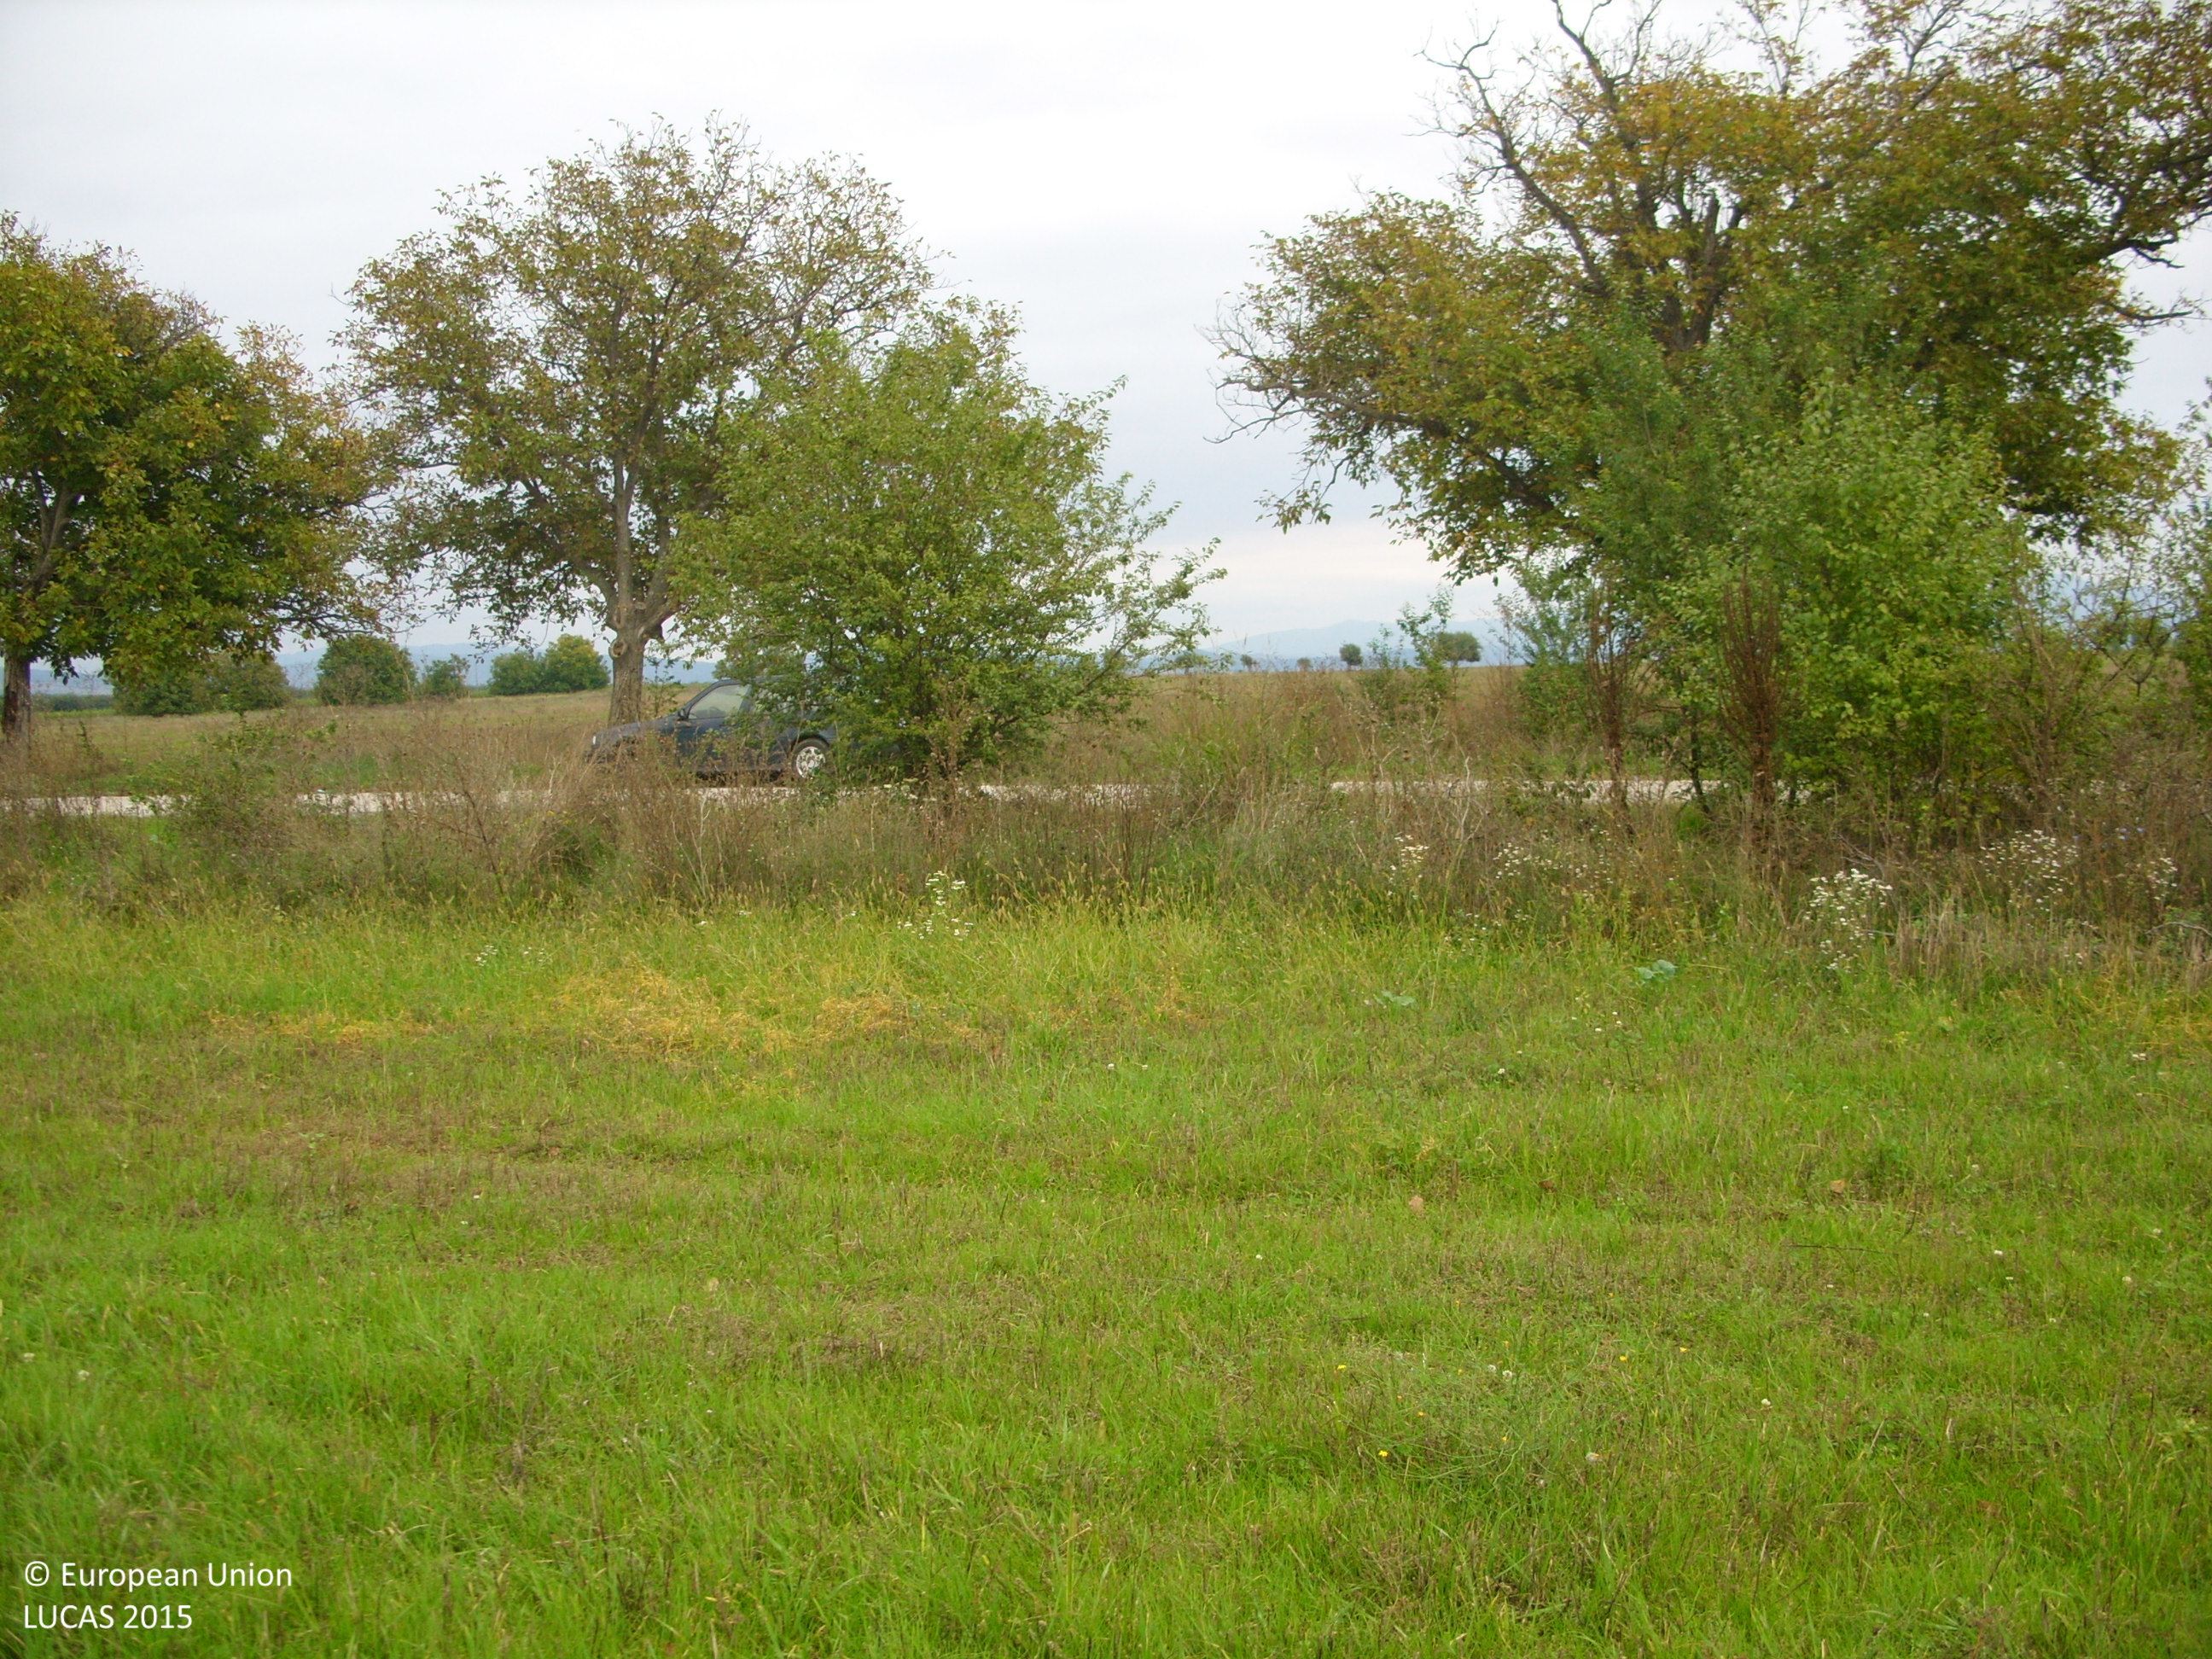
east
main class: Grassland
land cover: Grassland without tree/shrub cover
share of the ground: > 75 %
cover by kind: herbaceous plants 100 %
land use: Agriculture (excluding fallow land and kitchen gardens)
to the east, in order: Grassland without tree/shrub cover; Lines of trees; Paved roads, cycling and walking lanes; Lines of trees; Spontaneously vegetated surfaces
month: October
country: BG
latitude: 42.6089
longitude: 24.7701
